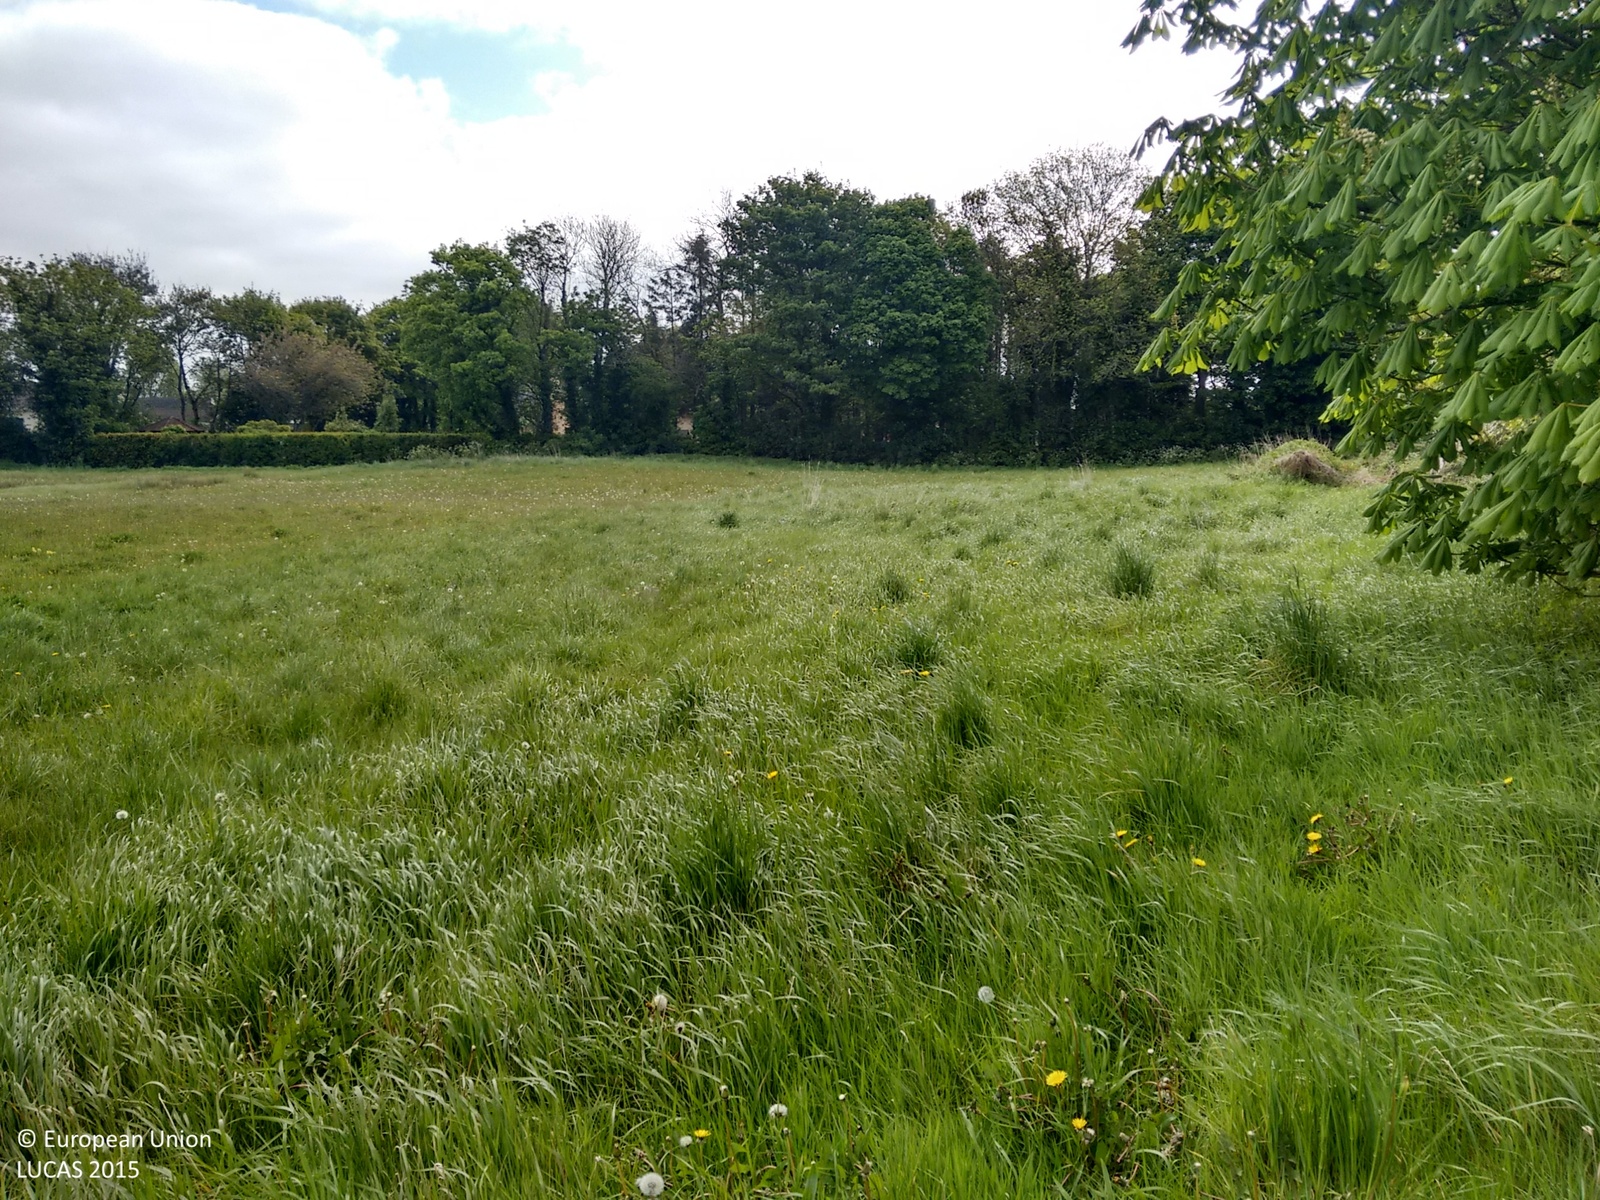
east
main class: Grassland
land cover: Grassland without tree/shrub cover
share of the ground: > 75 %
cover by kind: herbaceous plants 100 %
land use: Agriculture (excluding fallow land and kitchen gardens)
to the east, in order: Grassland without tree/shrub cover; Ditches and canals; Abandoned hedges; Fences; Tracks; Pine dominated mixed woodland; Electric lines; Paved roads, cycling and walking lanes; Artificial constructions in urban areas; Broadleaved woodland; Grassland without tree/shrub cover
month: May
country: IE
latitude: 53.2990
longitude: -6.6824
